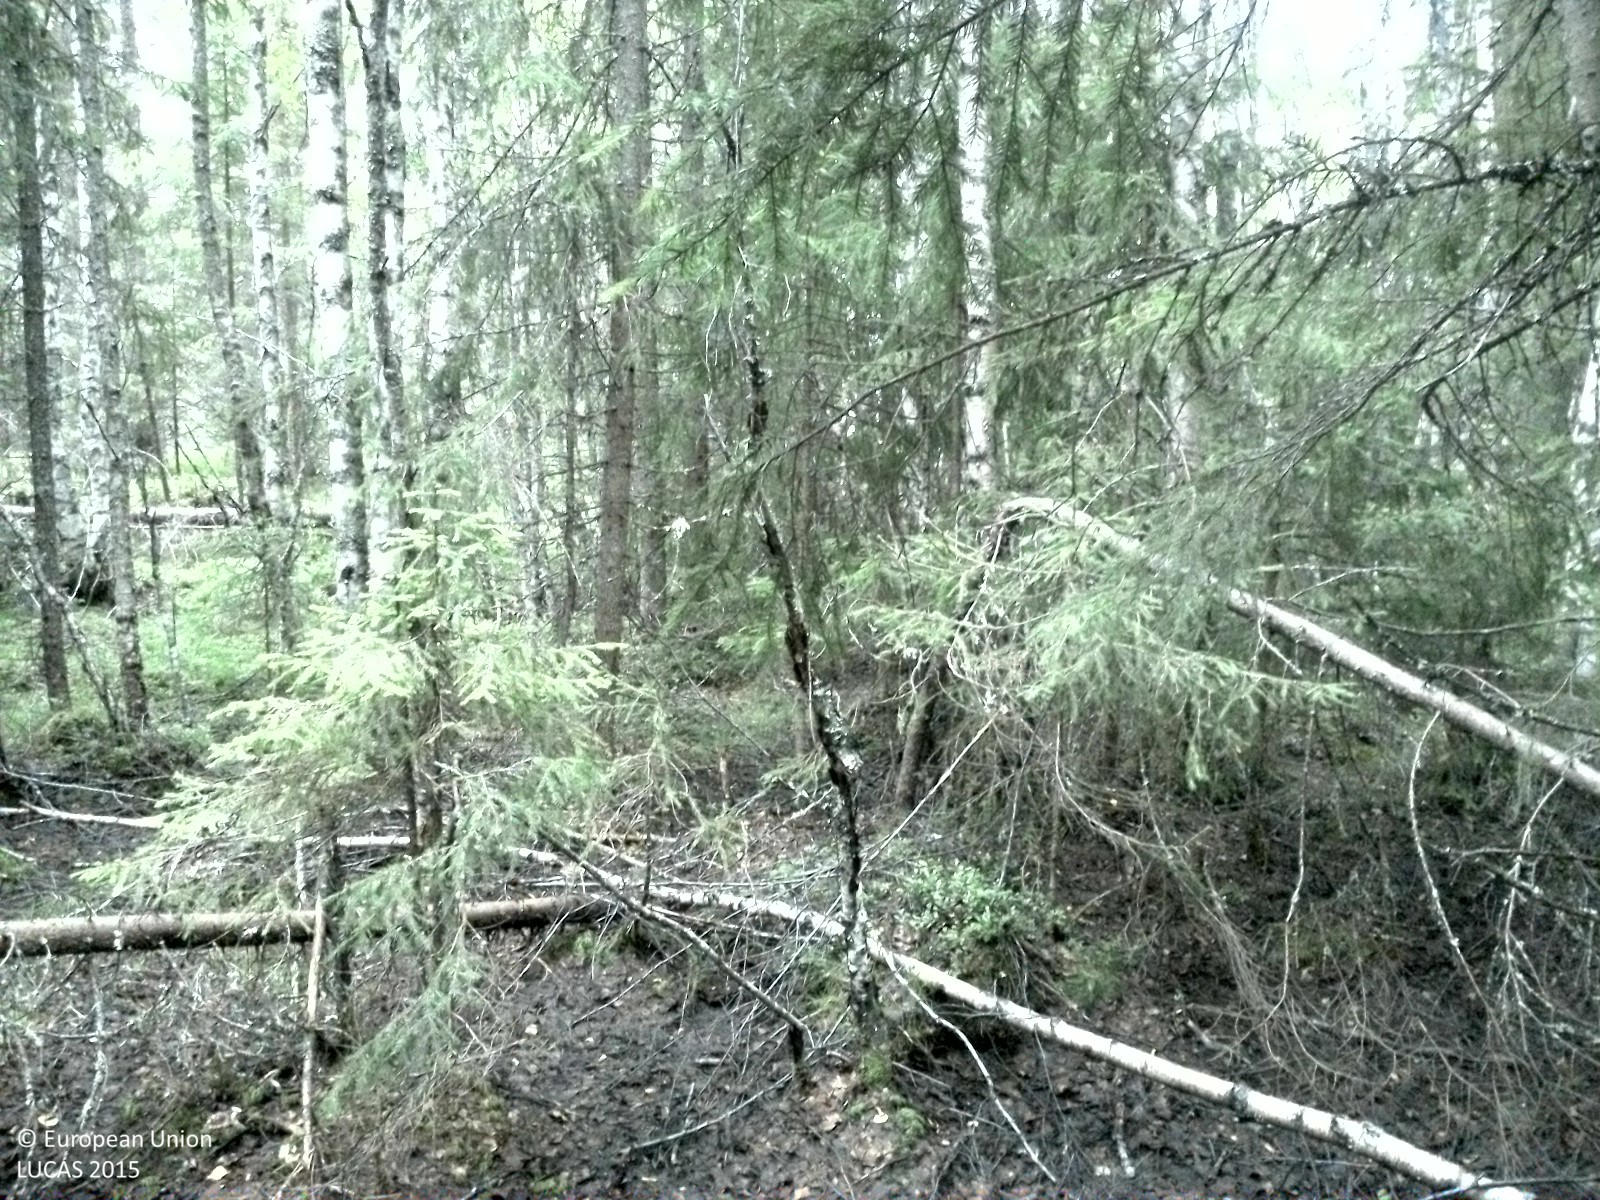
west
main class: Woodland
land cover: Spruce dominated mixed woodland
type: boreal forest
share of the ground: > 75 %
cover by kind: coniferous forest trees 50 %, broadleaved forest trees 30 %, lichens and mosses 10 %, unconsolidated bare surface 10 %
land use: Forestry
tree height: > 5 m
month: August
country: SE
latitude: 62.7301
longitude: 16.8057
